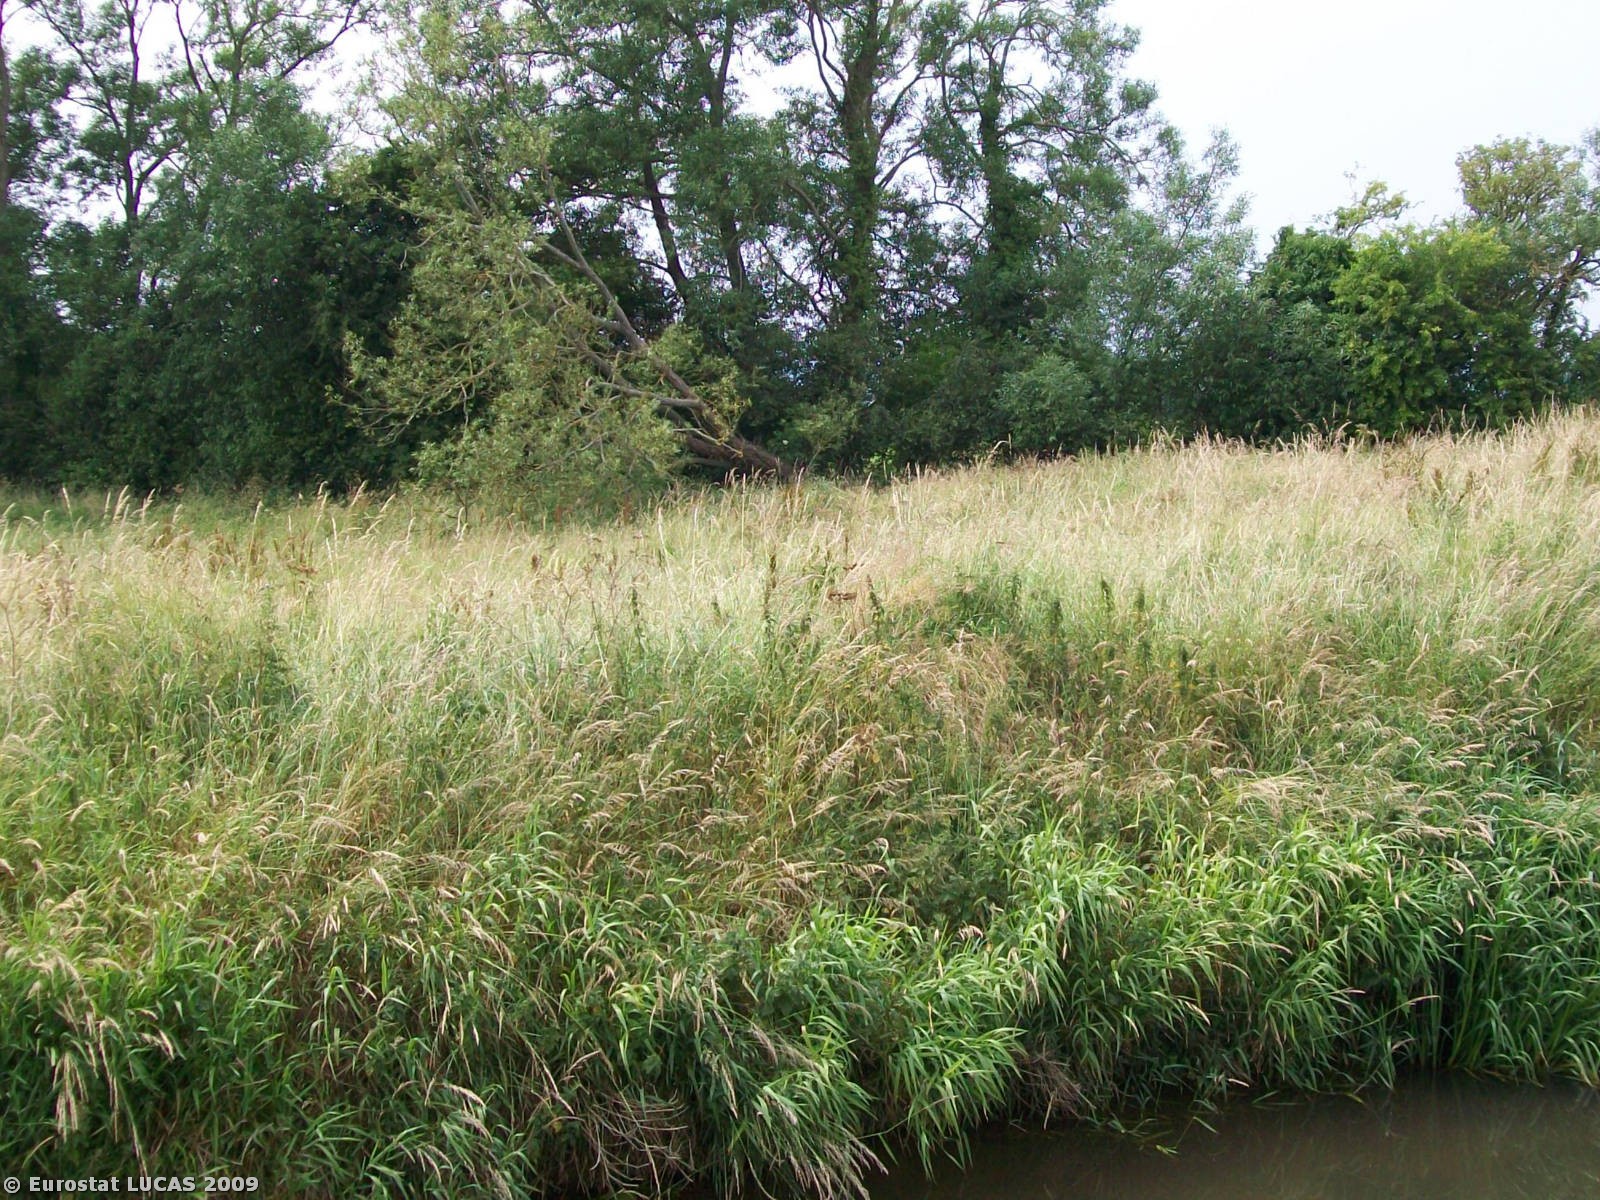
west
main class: Grassland
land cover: Grassland without tree/shrub cover
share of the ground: > 75 %
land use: Agriculture (excluding fallow land and kitchen gardens)
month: July
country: GB
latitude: 51.2286
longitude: -2.7732
